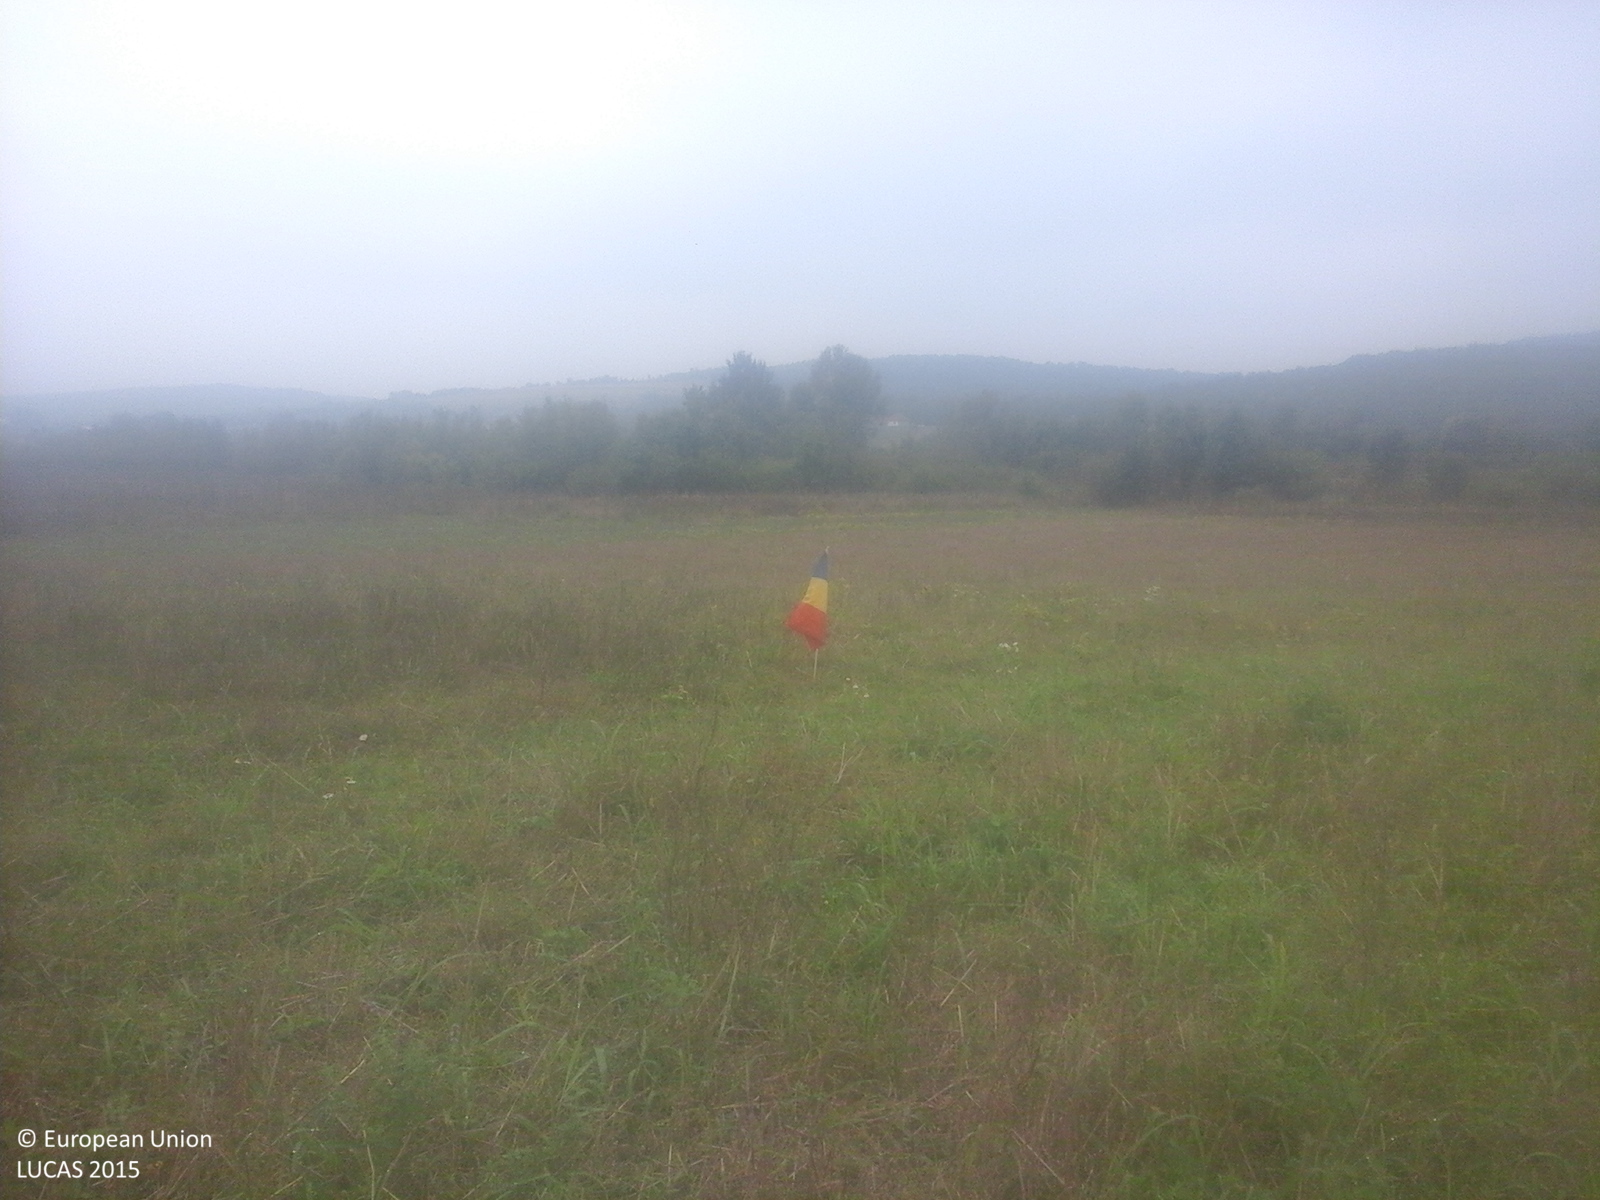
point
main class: Grassland
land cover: Spontaneously vegetated surfaces
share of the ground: > 75 %
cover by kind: herbaceous plants 100 %
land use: Fallow land
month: September
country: RO
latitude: 44.7382
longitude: 23.2480
